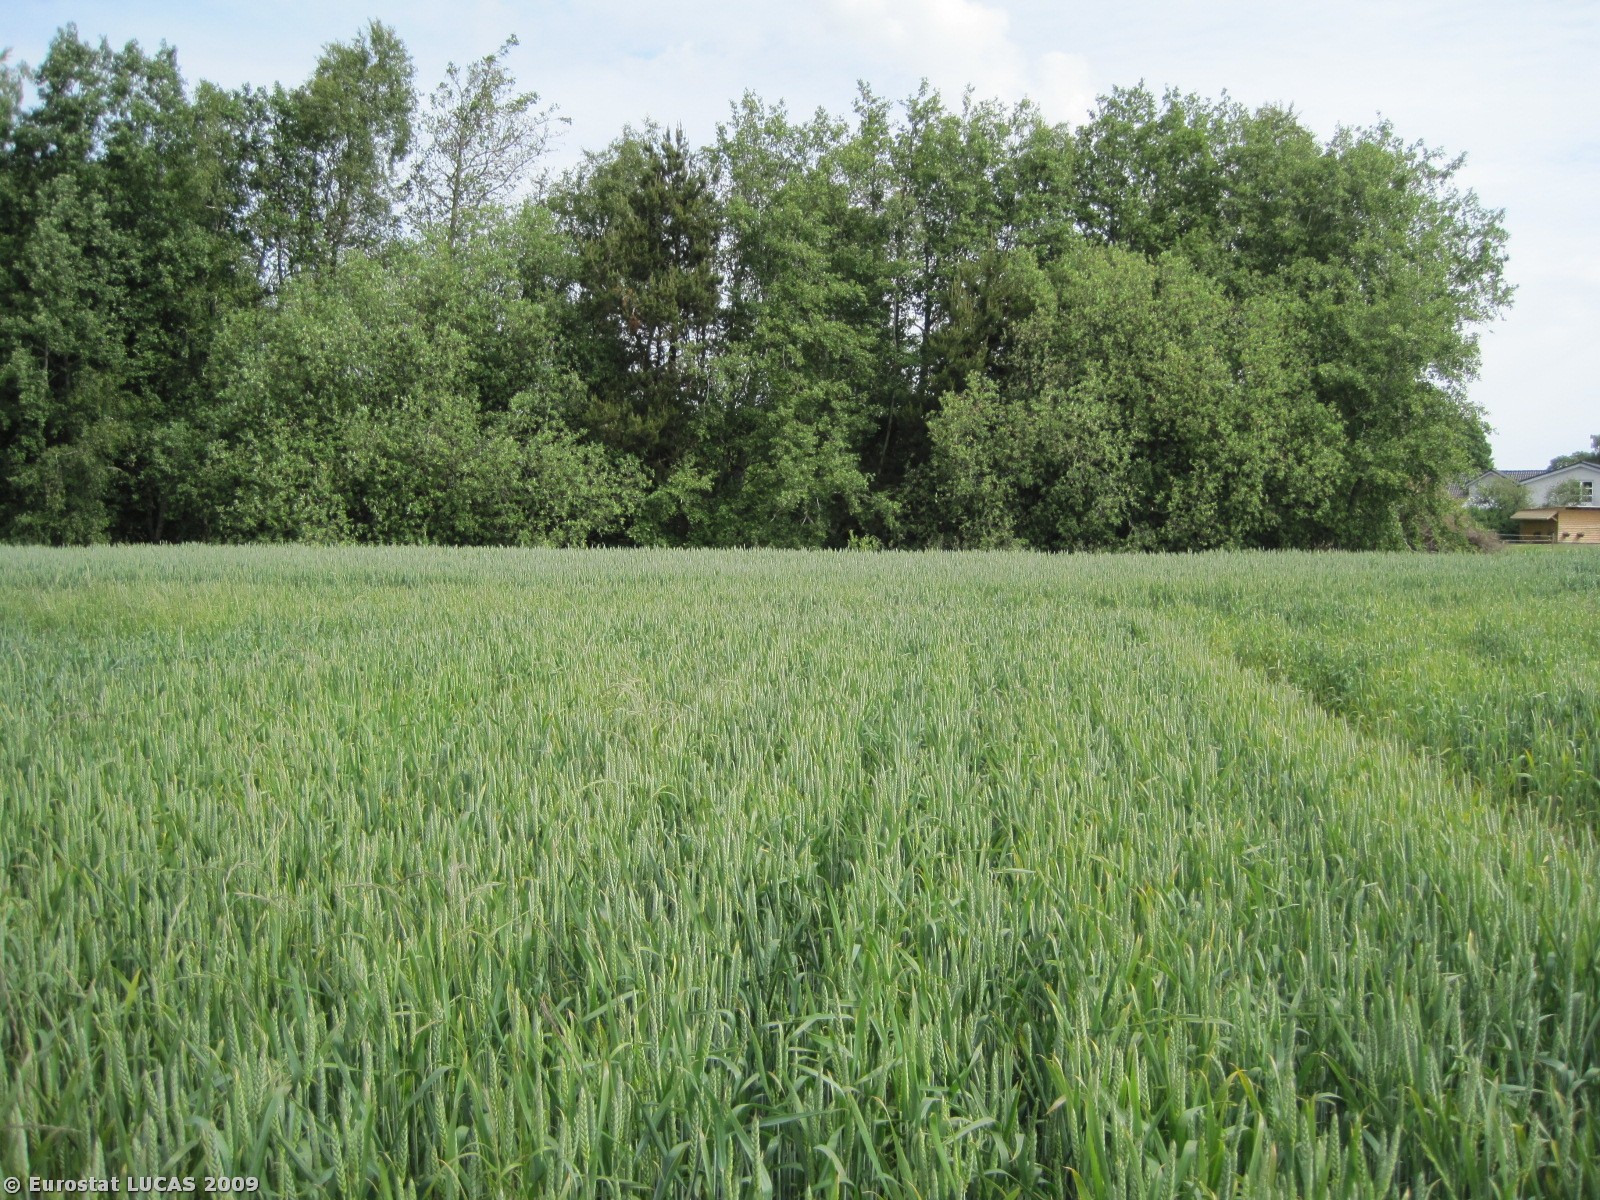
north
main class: Cropland
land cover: Common wheat
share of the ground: > 75 %
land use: Agriculture (excluding fallow land and kitchen gardens)
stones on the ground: < 10 %
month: June
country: DK
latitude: 57.0505
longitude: 10.1811
